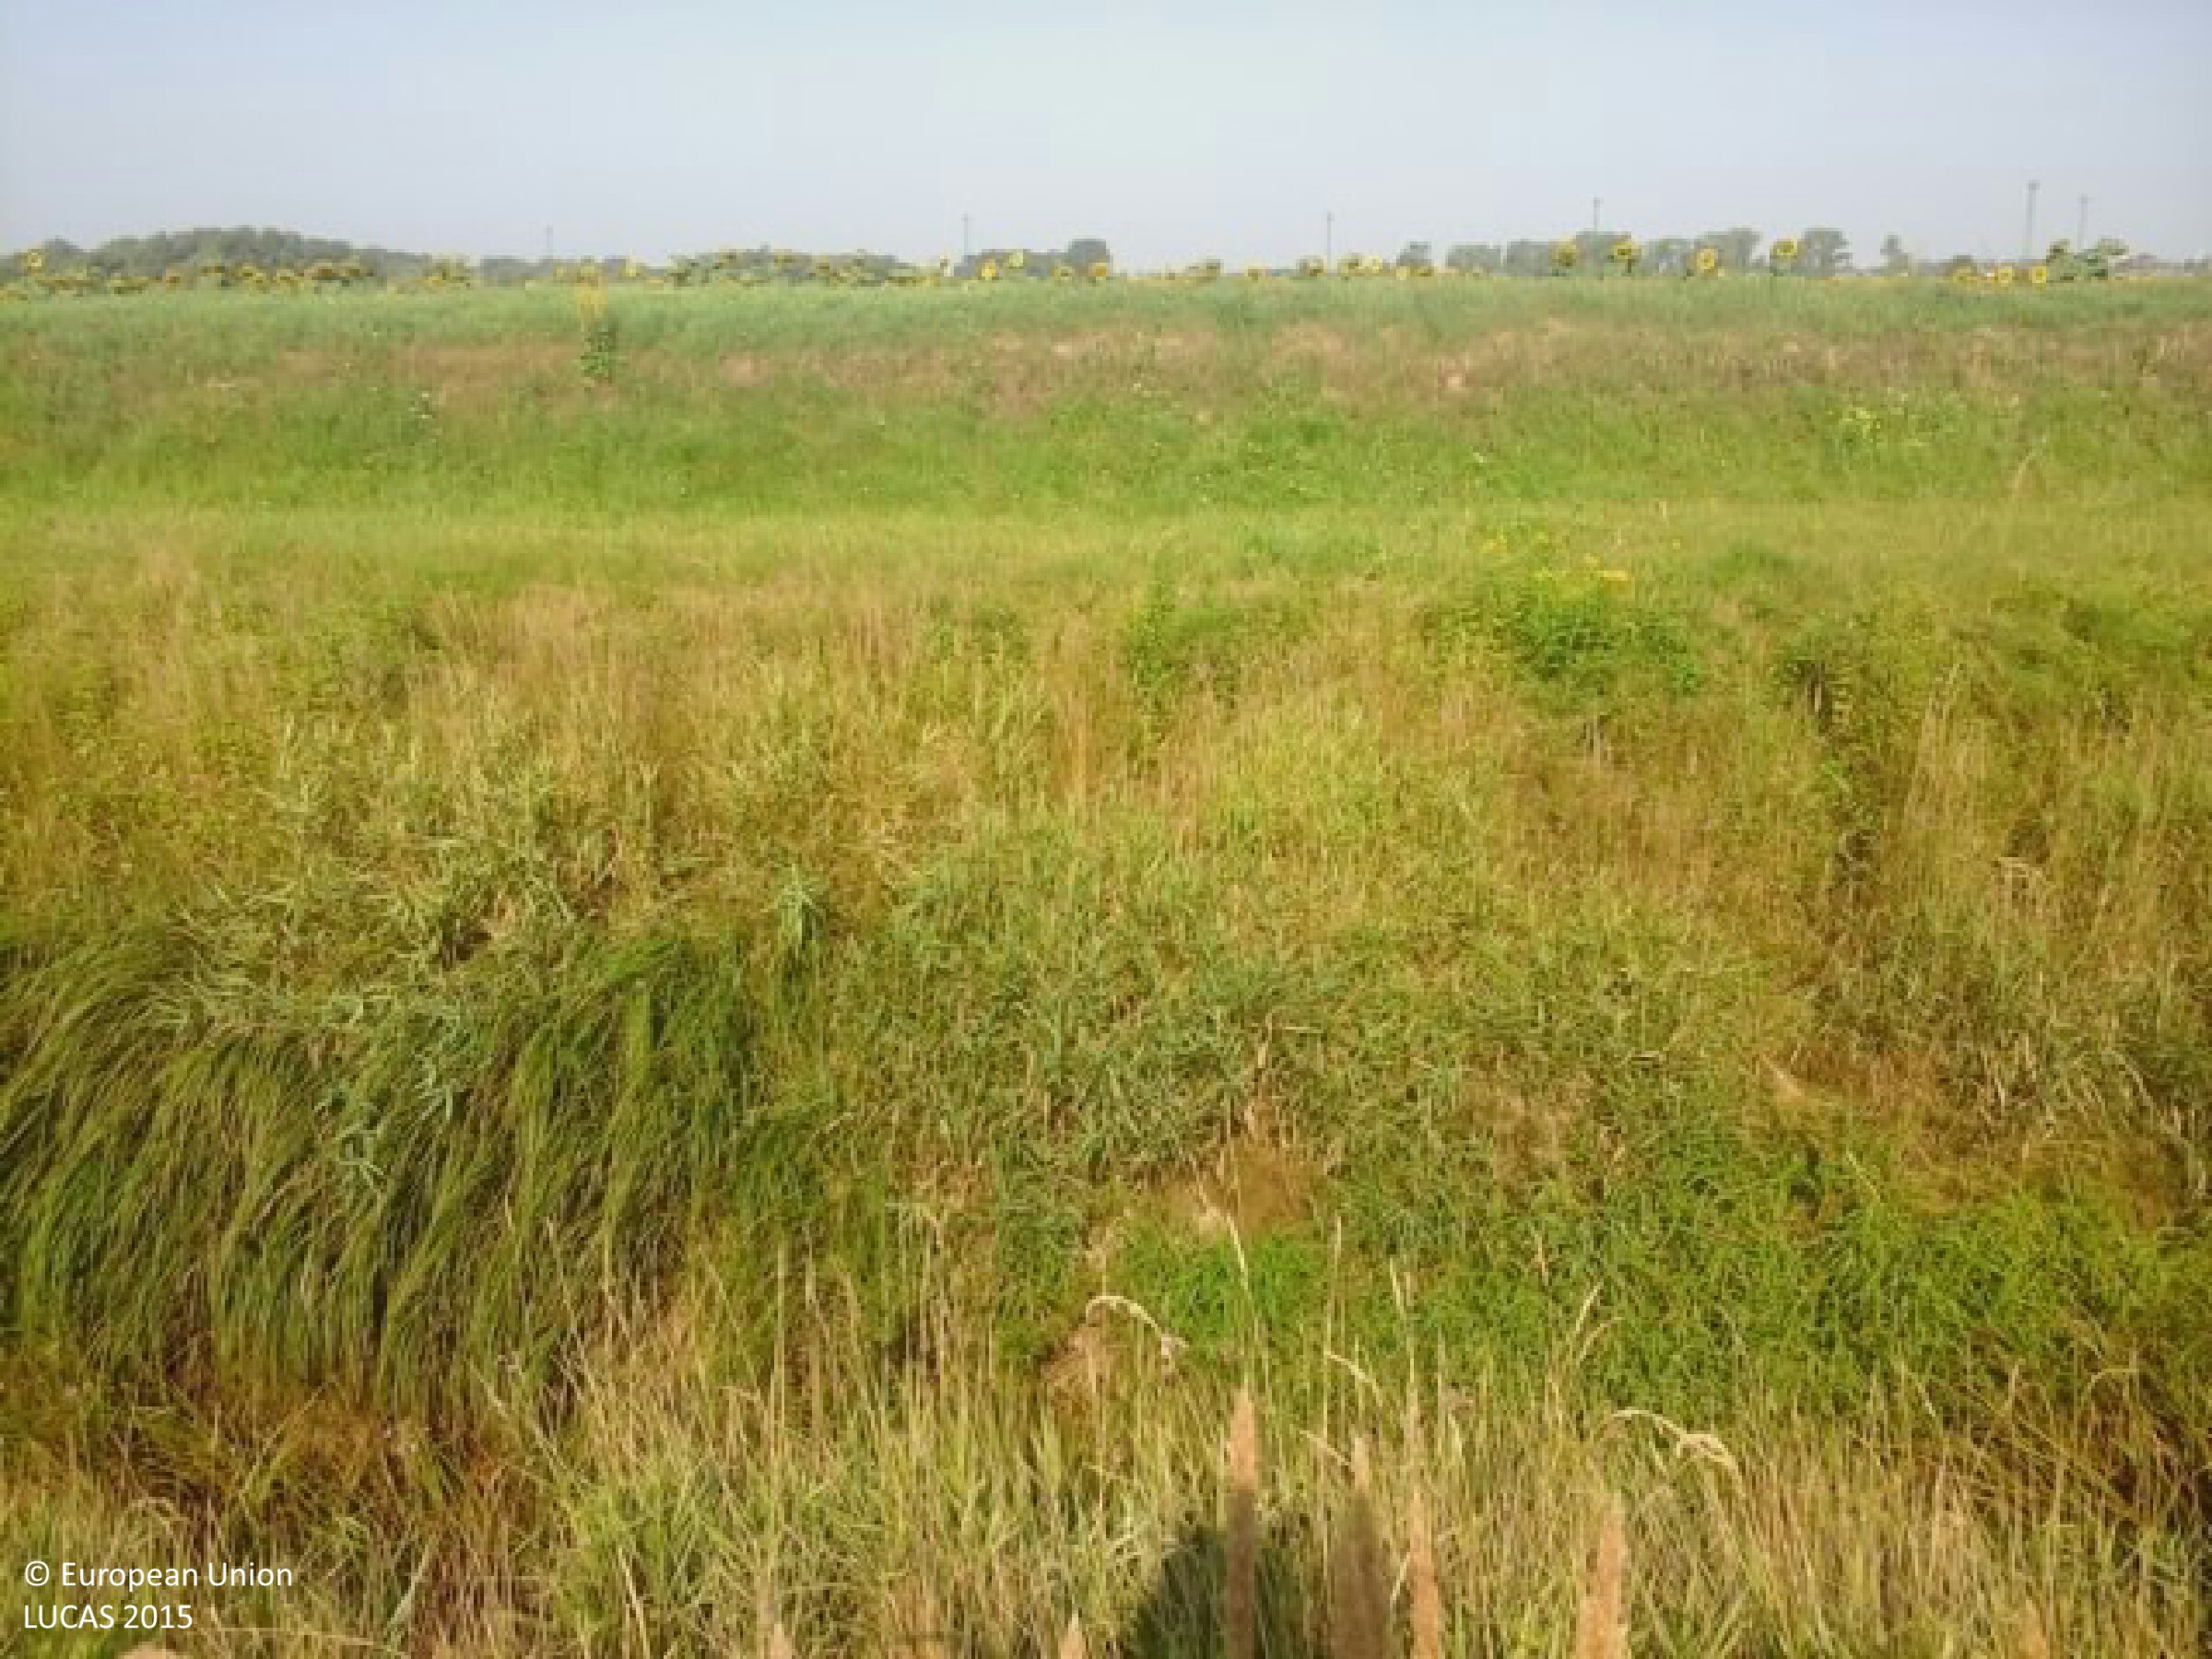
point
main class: Grassland
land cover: Grassland without tree/shrub cover
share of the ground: > 75 %
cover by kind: herbaceous plants 100 %
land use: Protection infrastructures
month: August
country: HU
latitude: 46.3650
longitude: 18.1576
